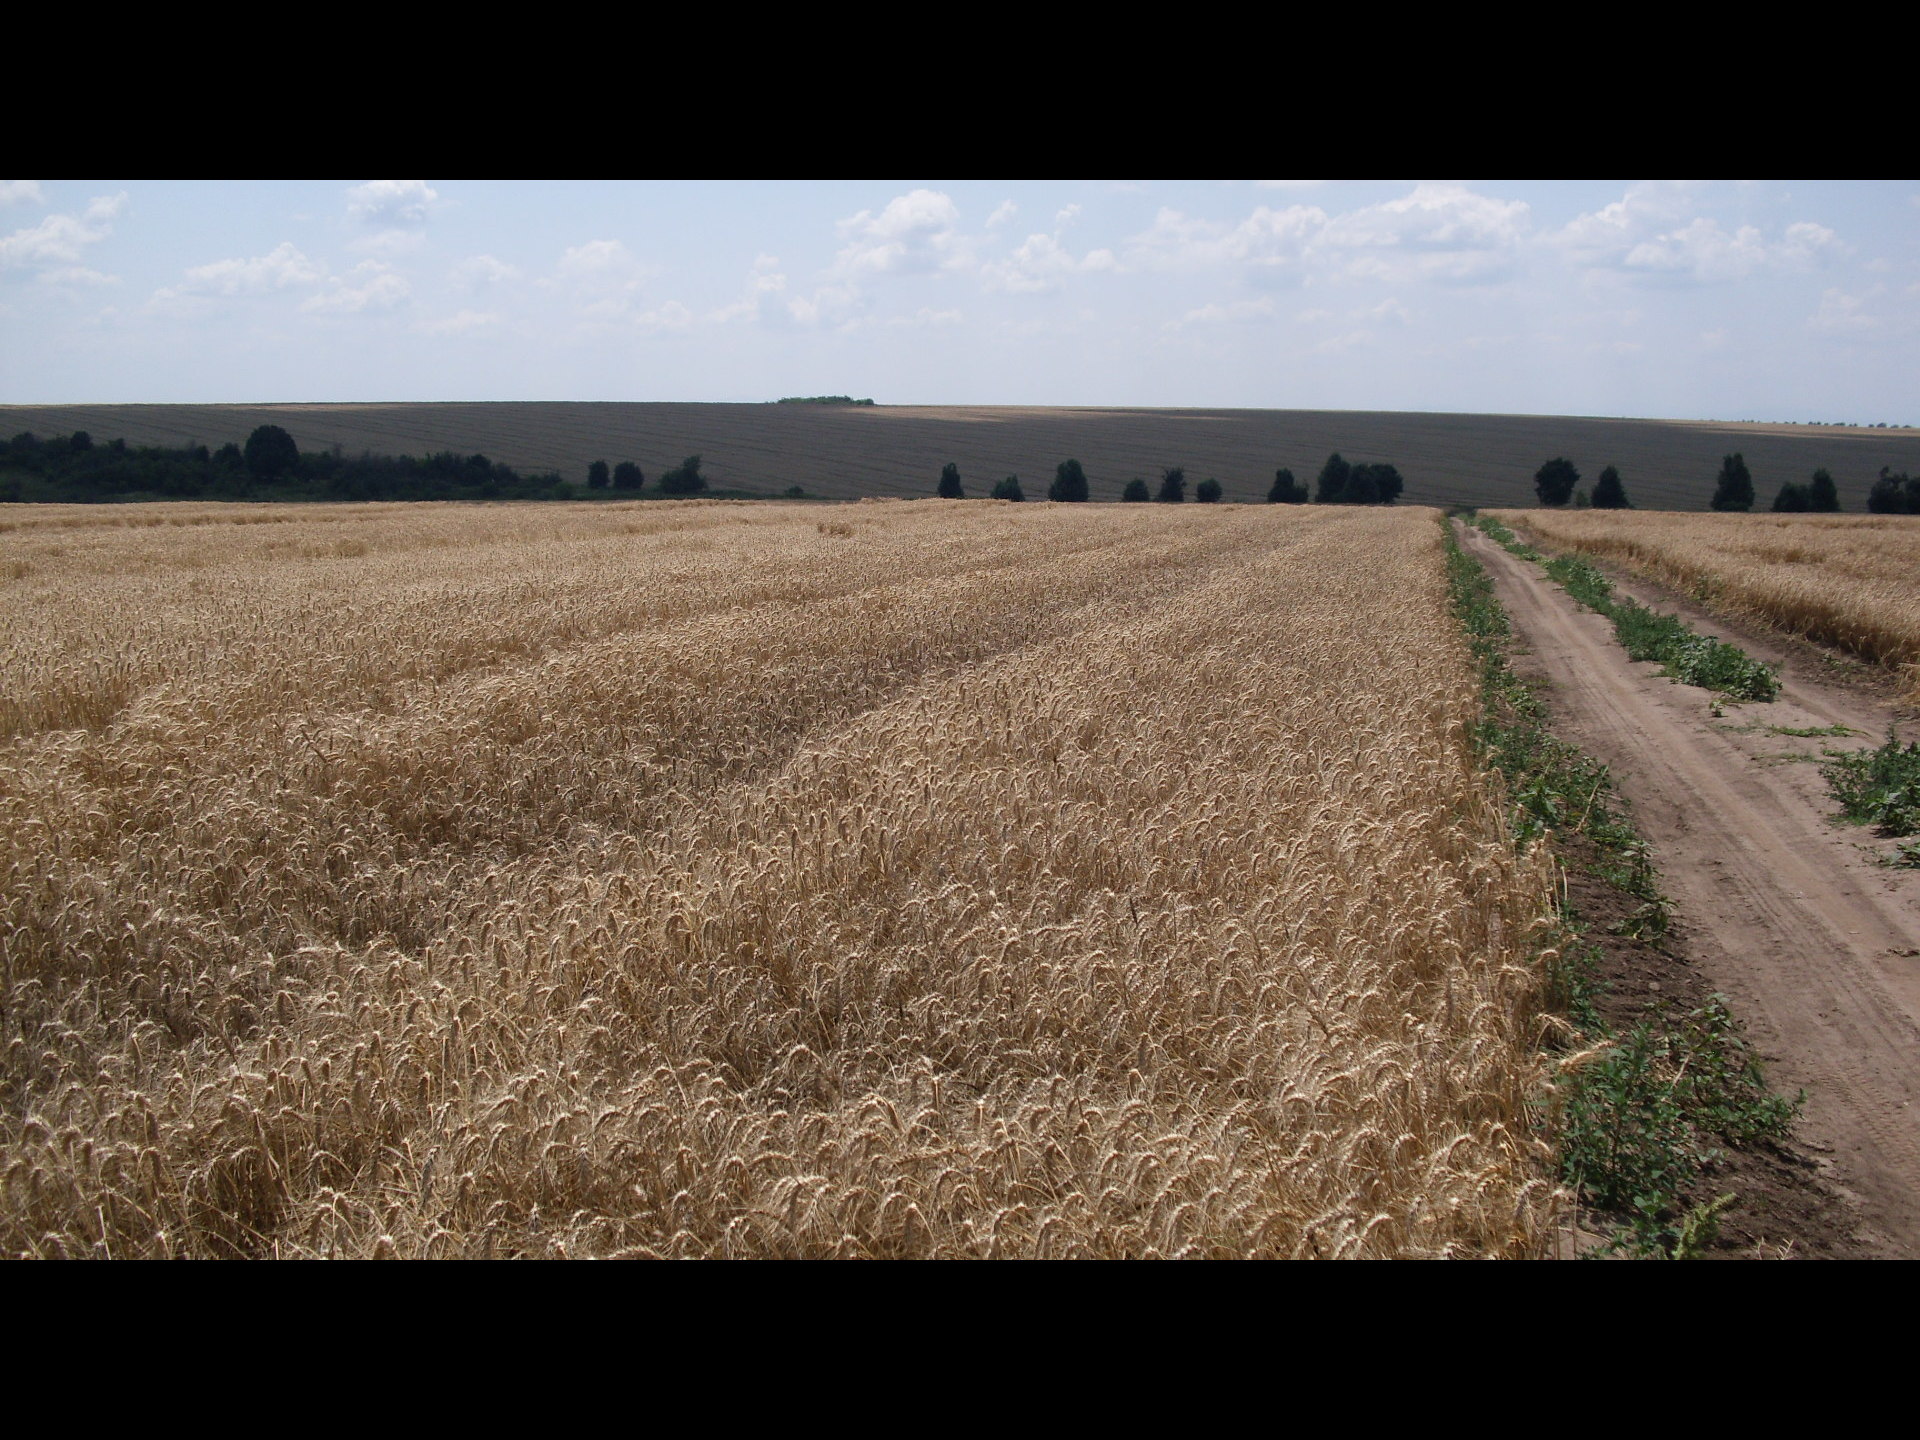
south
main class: Cropland
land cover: Common wheat
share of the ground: > 75 %
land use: Agriculture (excluding fallow land and kitchen gardens)
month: July
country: BG
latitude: 43.7820
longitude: 23.3021
